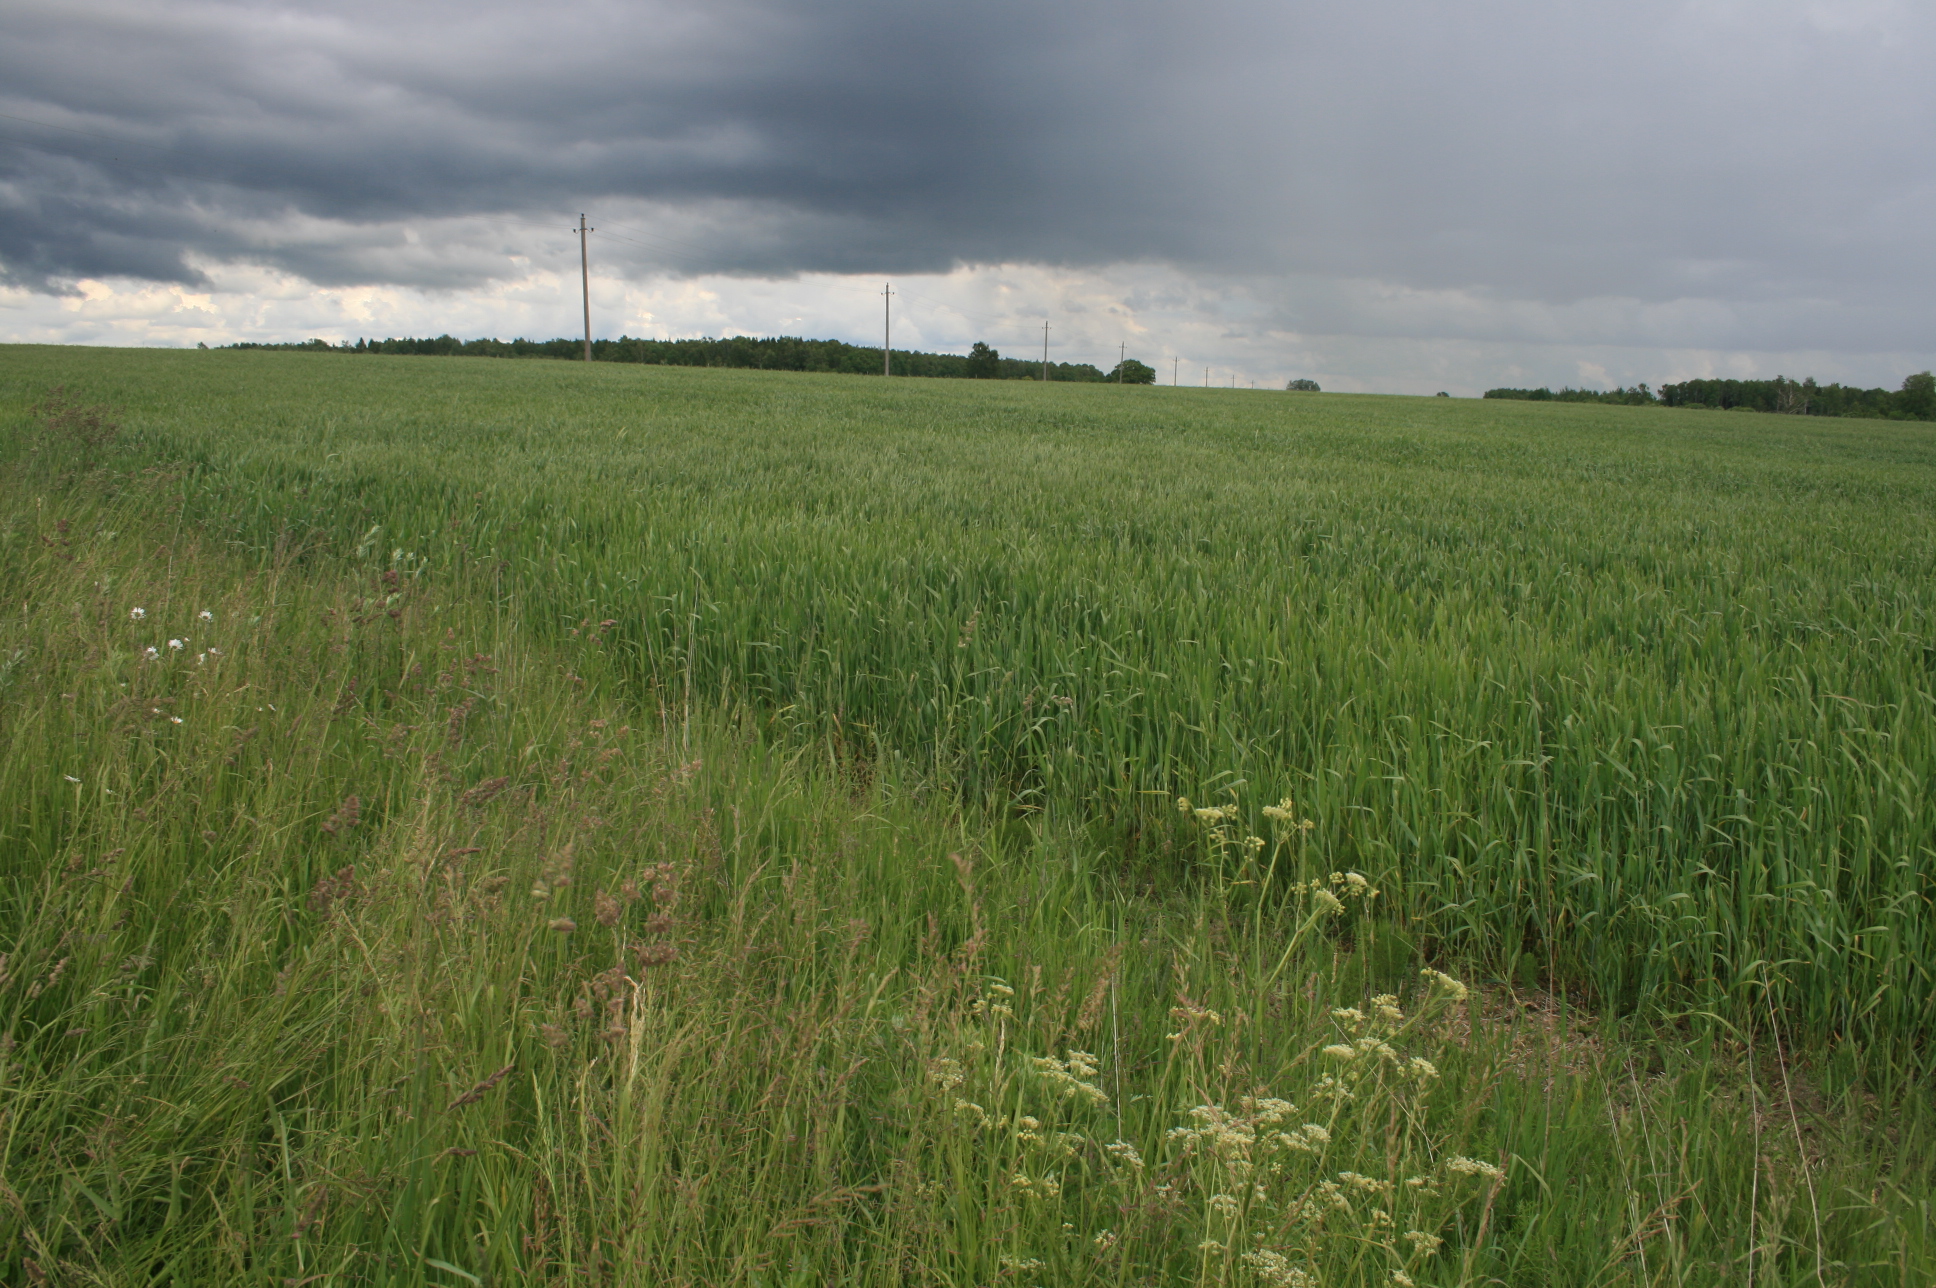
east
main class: Grassland
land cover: Grassland without tree/shrub cover
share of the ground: > 75 %
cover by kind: herbaceous plants 100 %
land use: Agriculture (excluding fallow land and kitchen gardens)
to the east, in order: Grassland without tree/shrub cover; Common wheat; Electric lines; Common wheat; Tracks; Common wheat
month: June
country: LT
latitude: 55.4258
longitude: 22.3359
